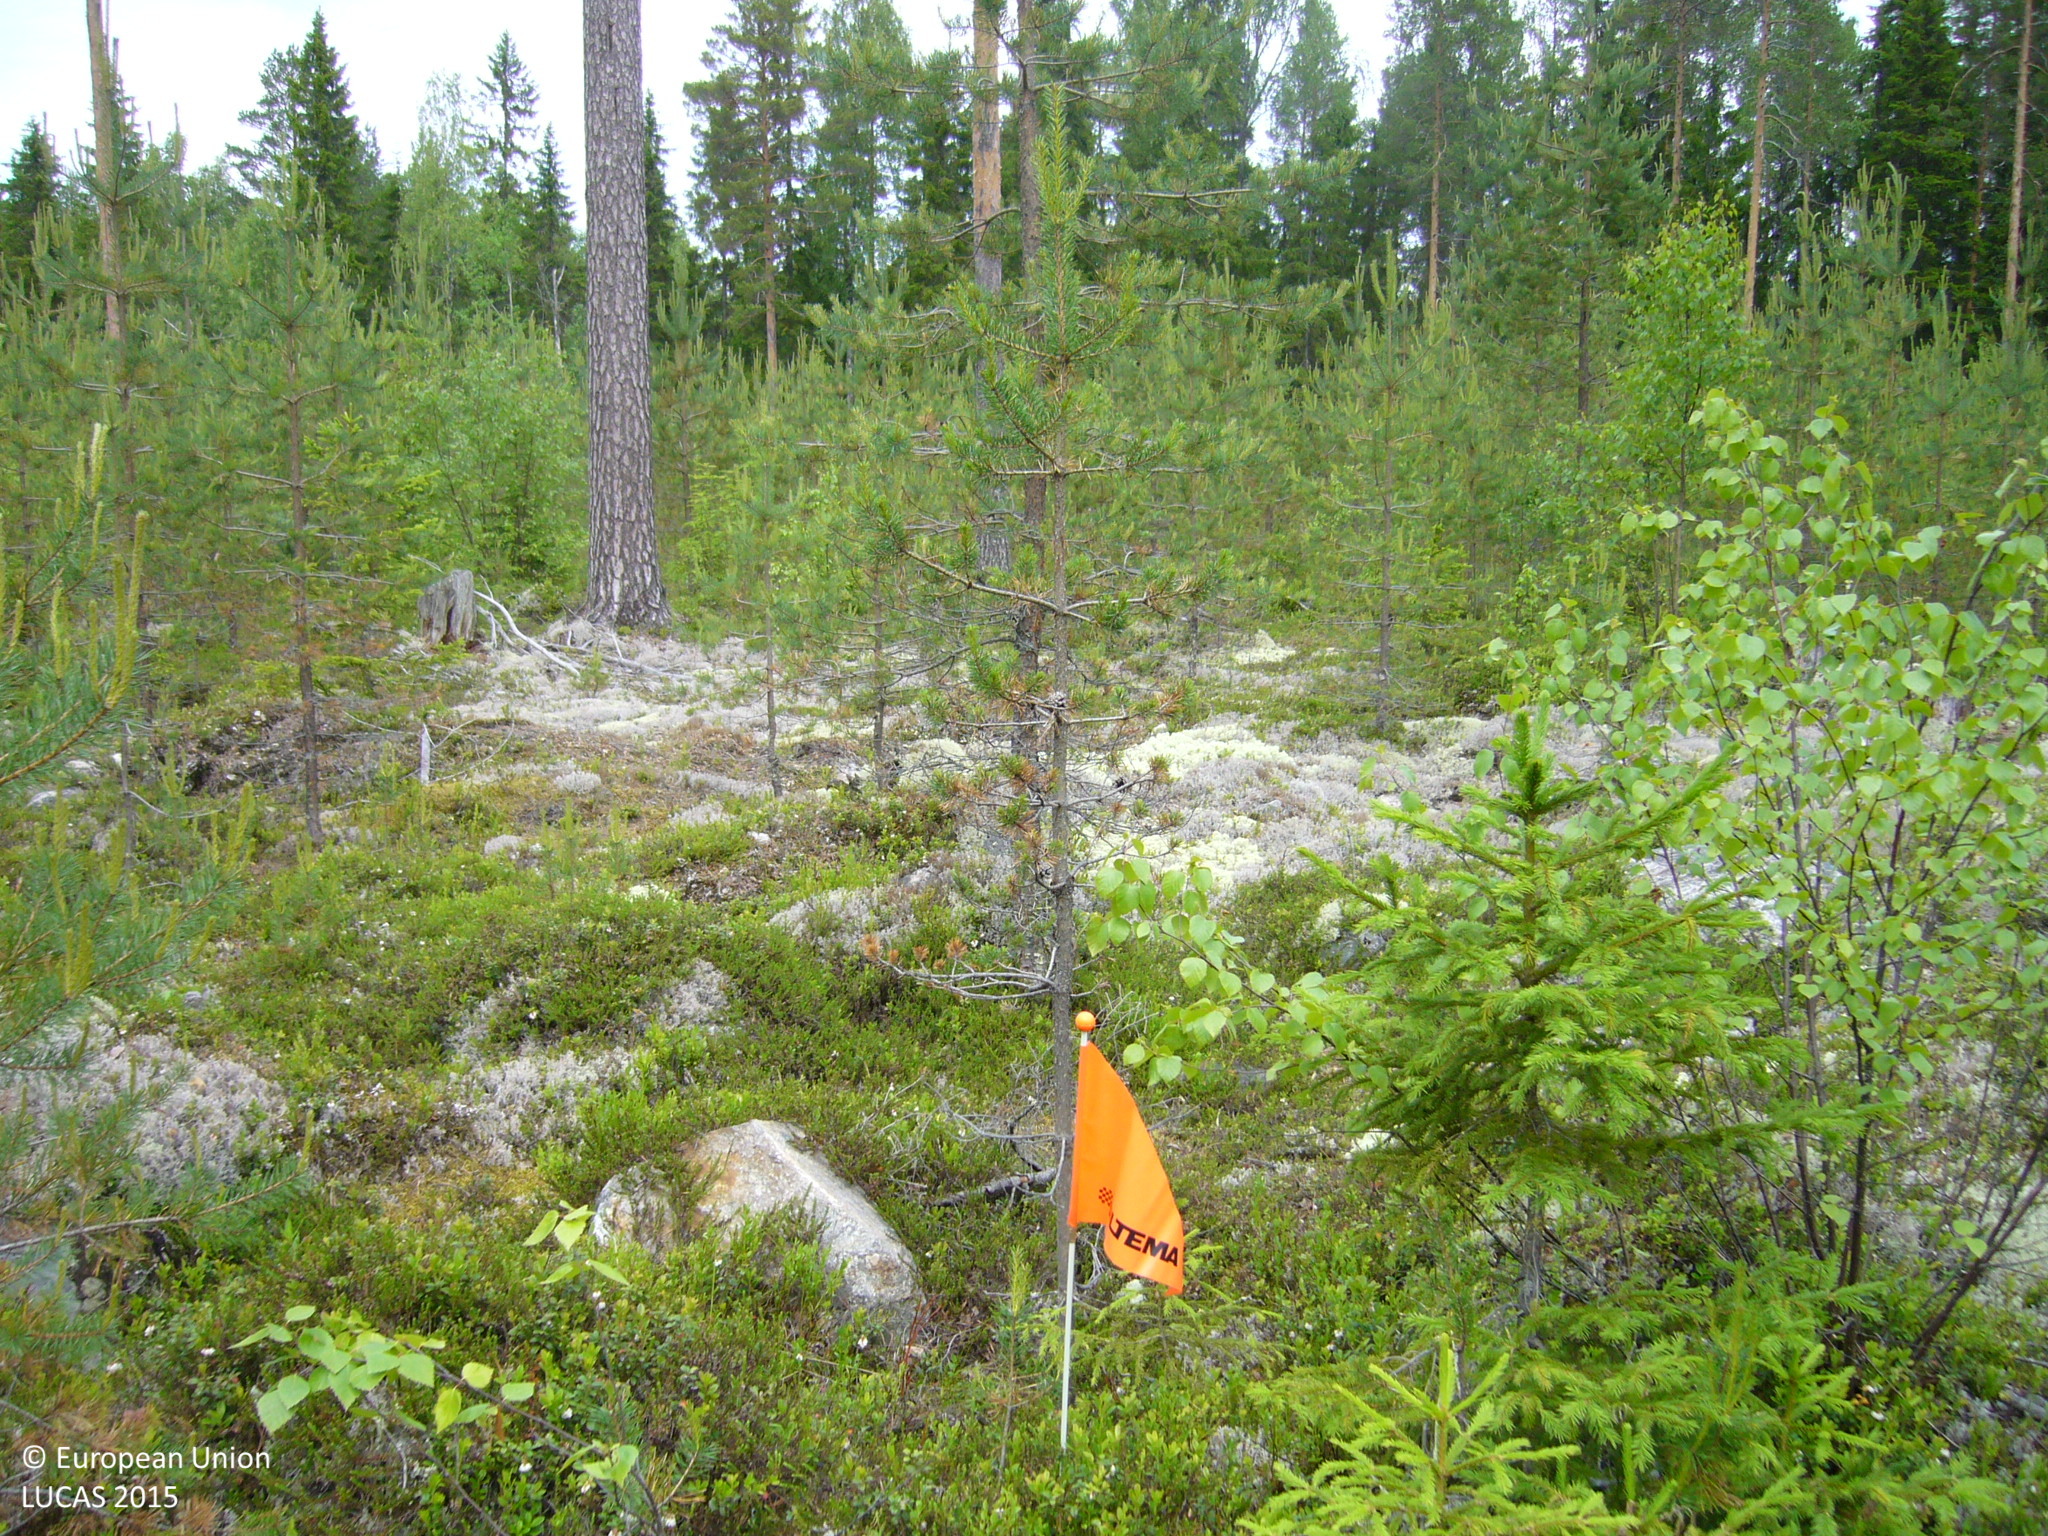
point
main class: Woodland
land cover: Pine dominated coniferous woodland
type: boreal forest
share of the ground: 50 - 75 %
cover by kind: coniferous forest trees 50 %, lichens and mosses 40 %, shrubs 10 %
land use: Forestry
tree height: > 5 m
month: July
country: FI
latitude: 63.4349
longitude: 26.1314
